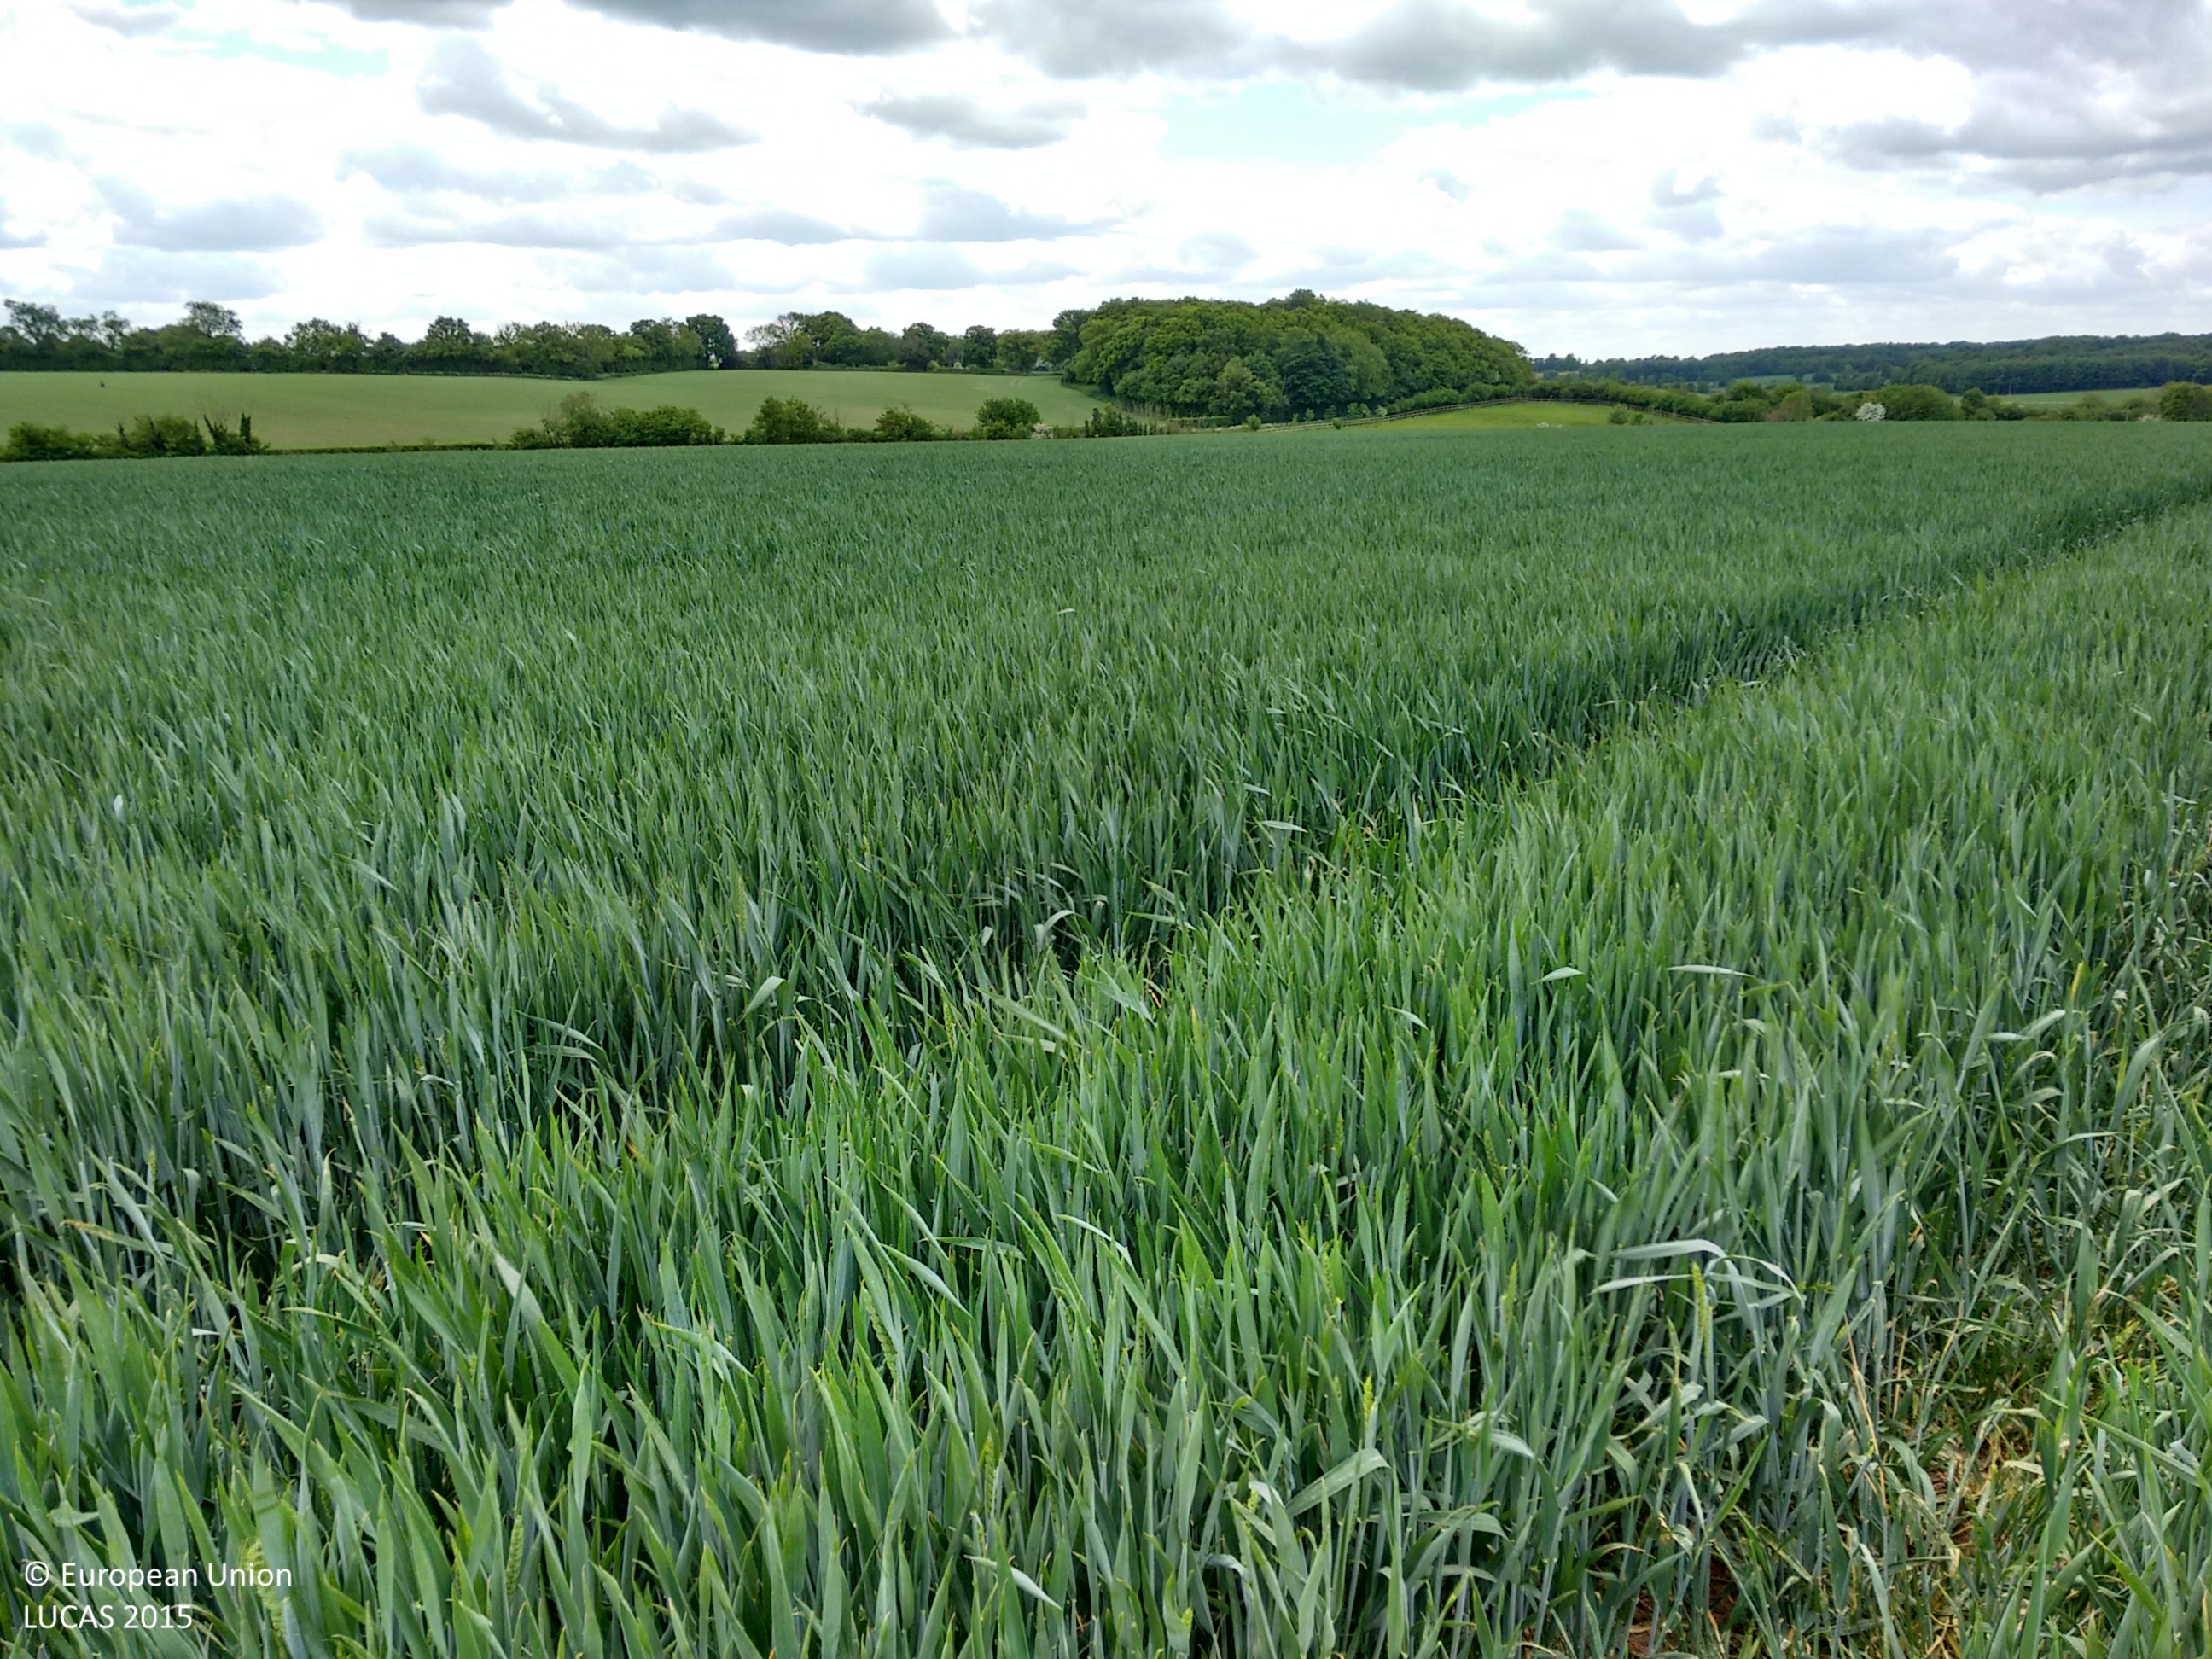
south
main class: Cropland
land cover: Common wheat
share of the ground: > 75 %
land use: Agriculture (excluding fallow land and kitchen gardens)
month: May
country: GB
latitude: 51.9260
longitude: 0.0943
